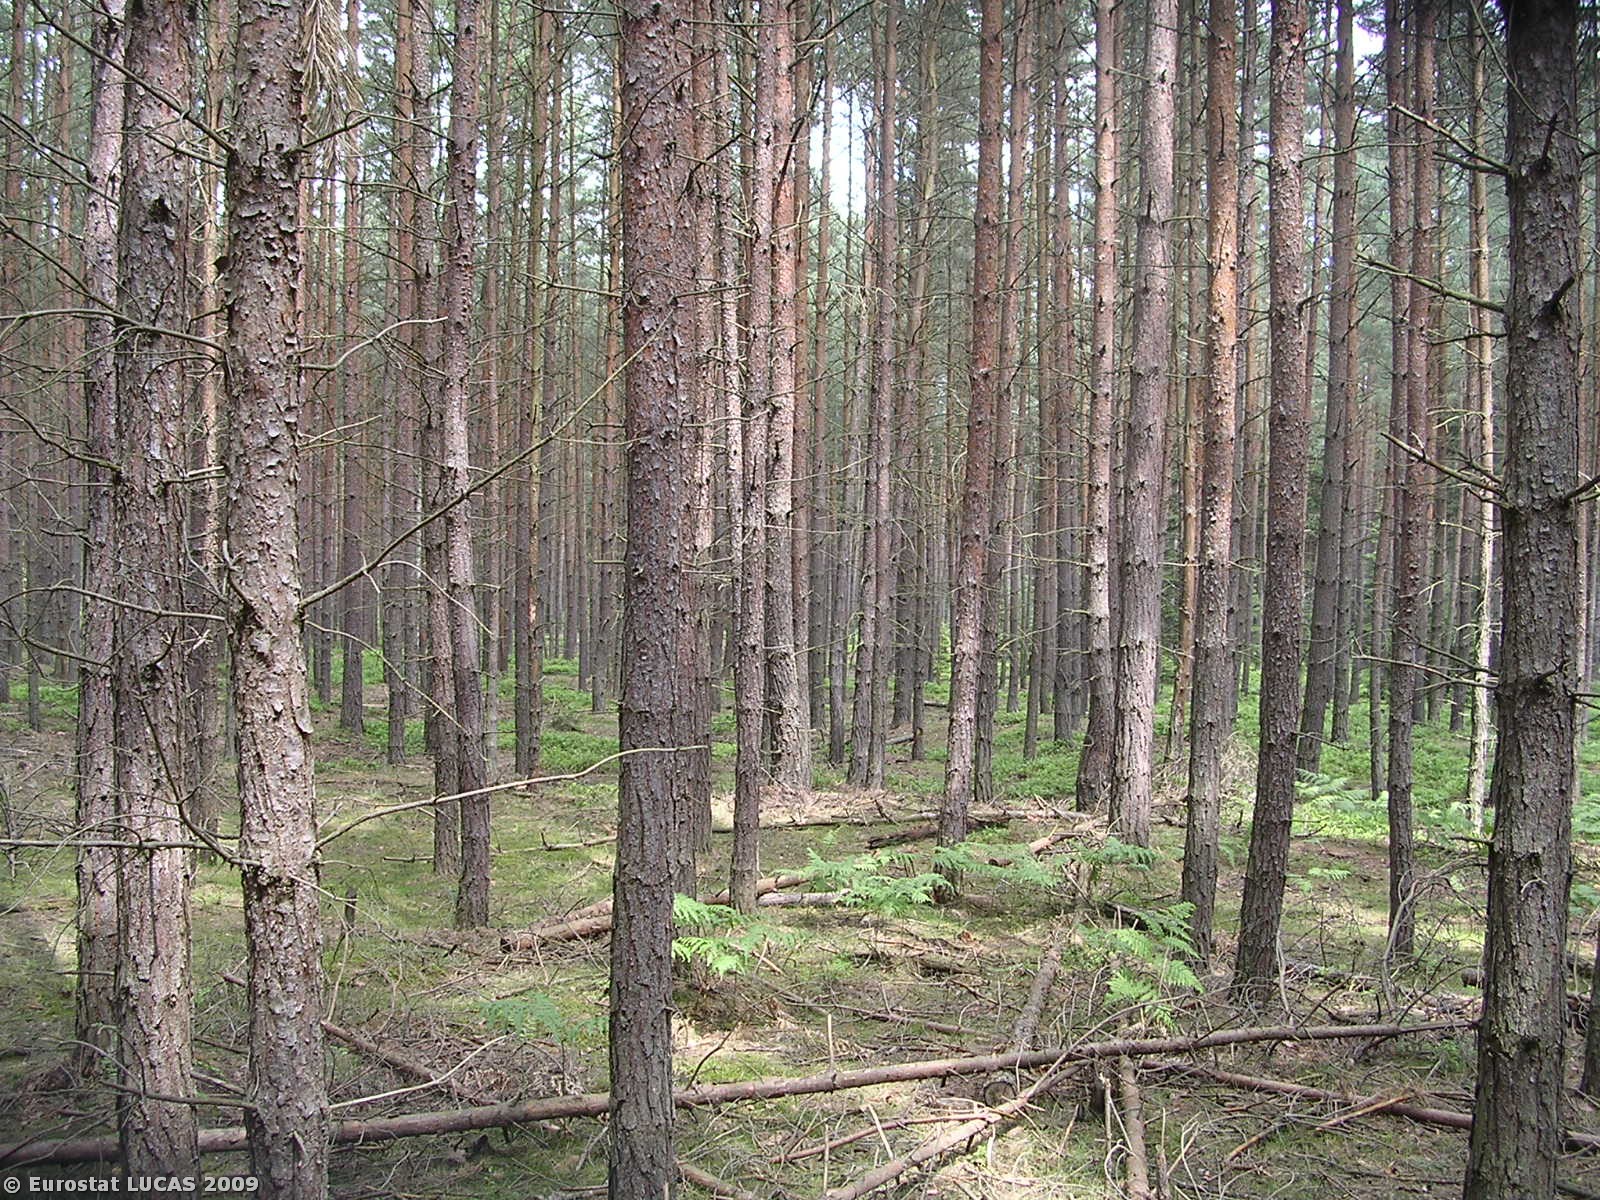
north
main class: Woodland
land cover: Coniferous woodland
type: hemiboreal forest and nemoral coniferous forest and mixed broadleaved-coniferous forest
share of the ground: > 75 %
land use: Forestry
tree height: > 5 m
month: June
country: CZ
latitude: 50.5544
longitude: 14.7307
